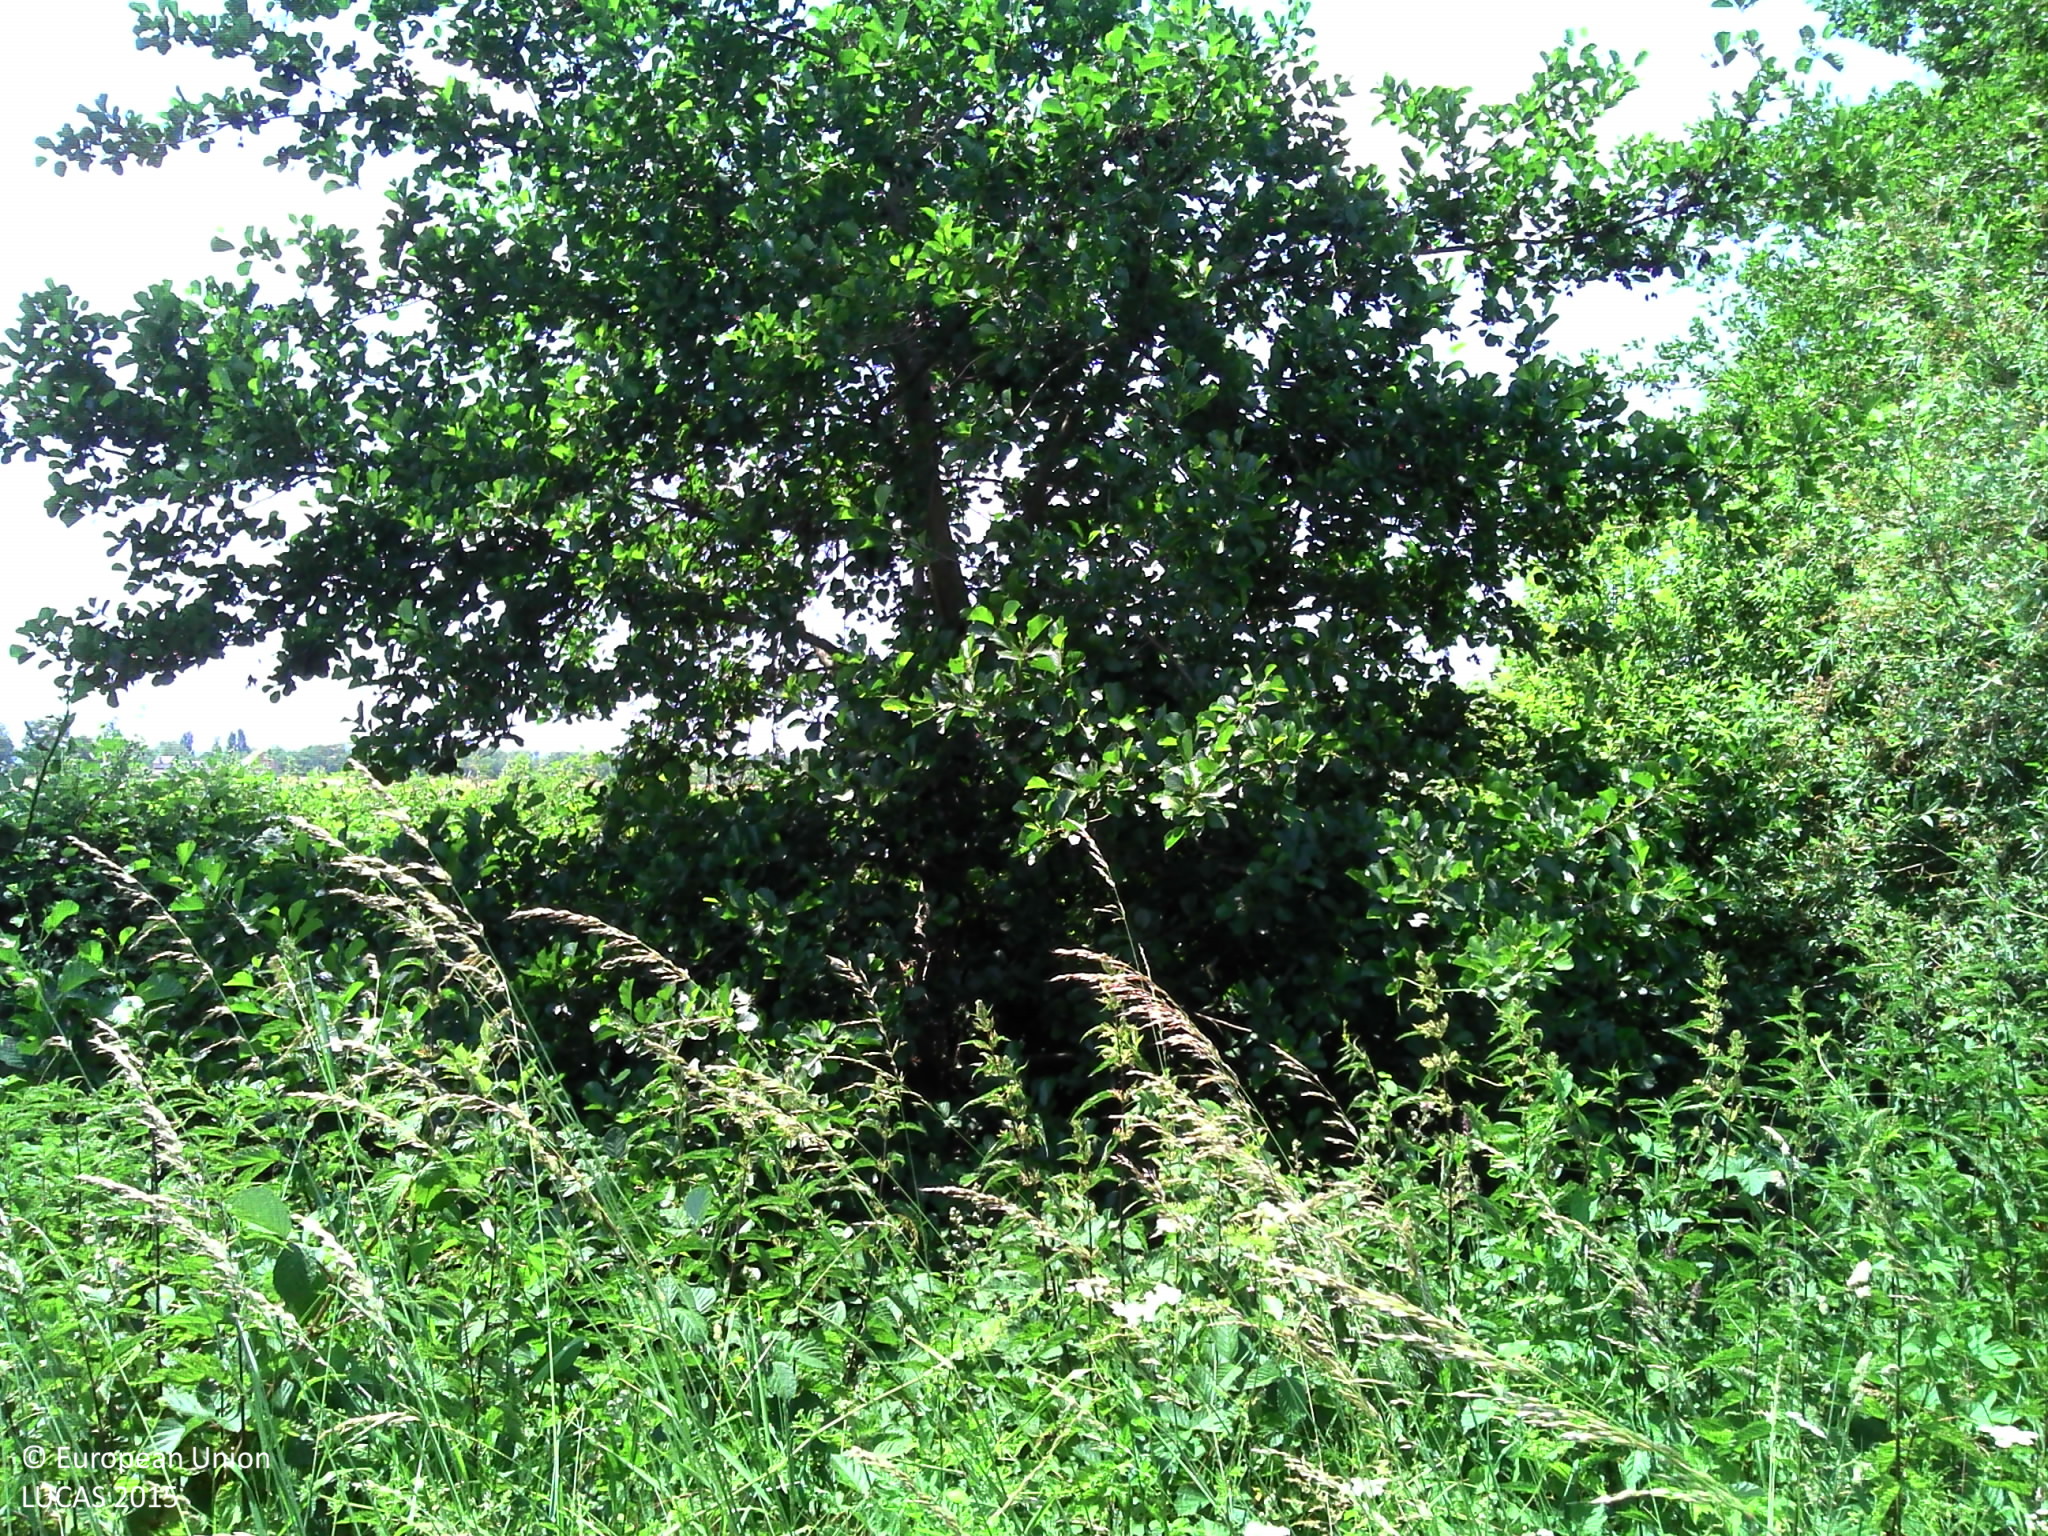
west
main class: Grassland
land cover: Spontaneously vegetated surfaces
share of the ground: > 75 %
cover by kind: herbaceous plants 95 %, shrubs 5 %
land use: Semi-natural and natural areas not in use
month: June
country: FR
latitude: 47.0239
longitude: 4.9091
